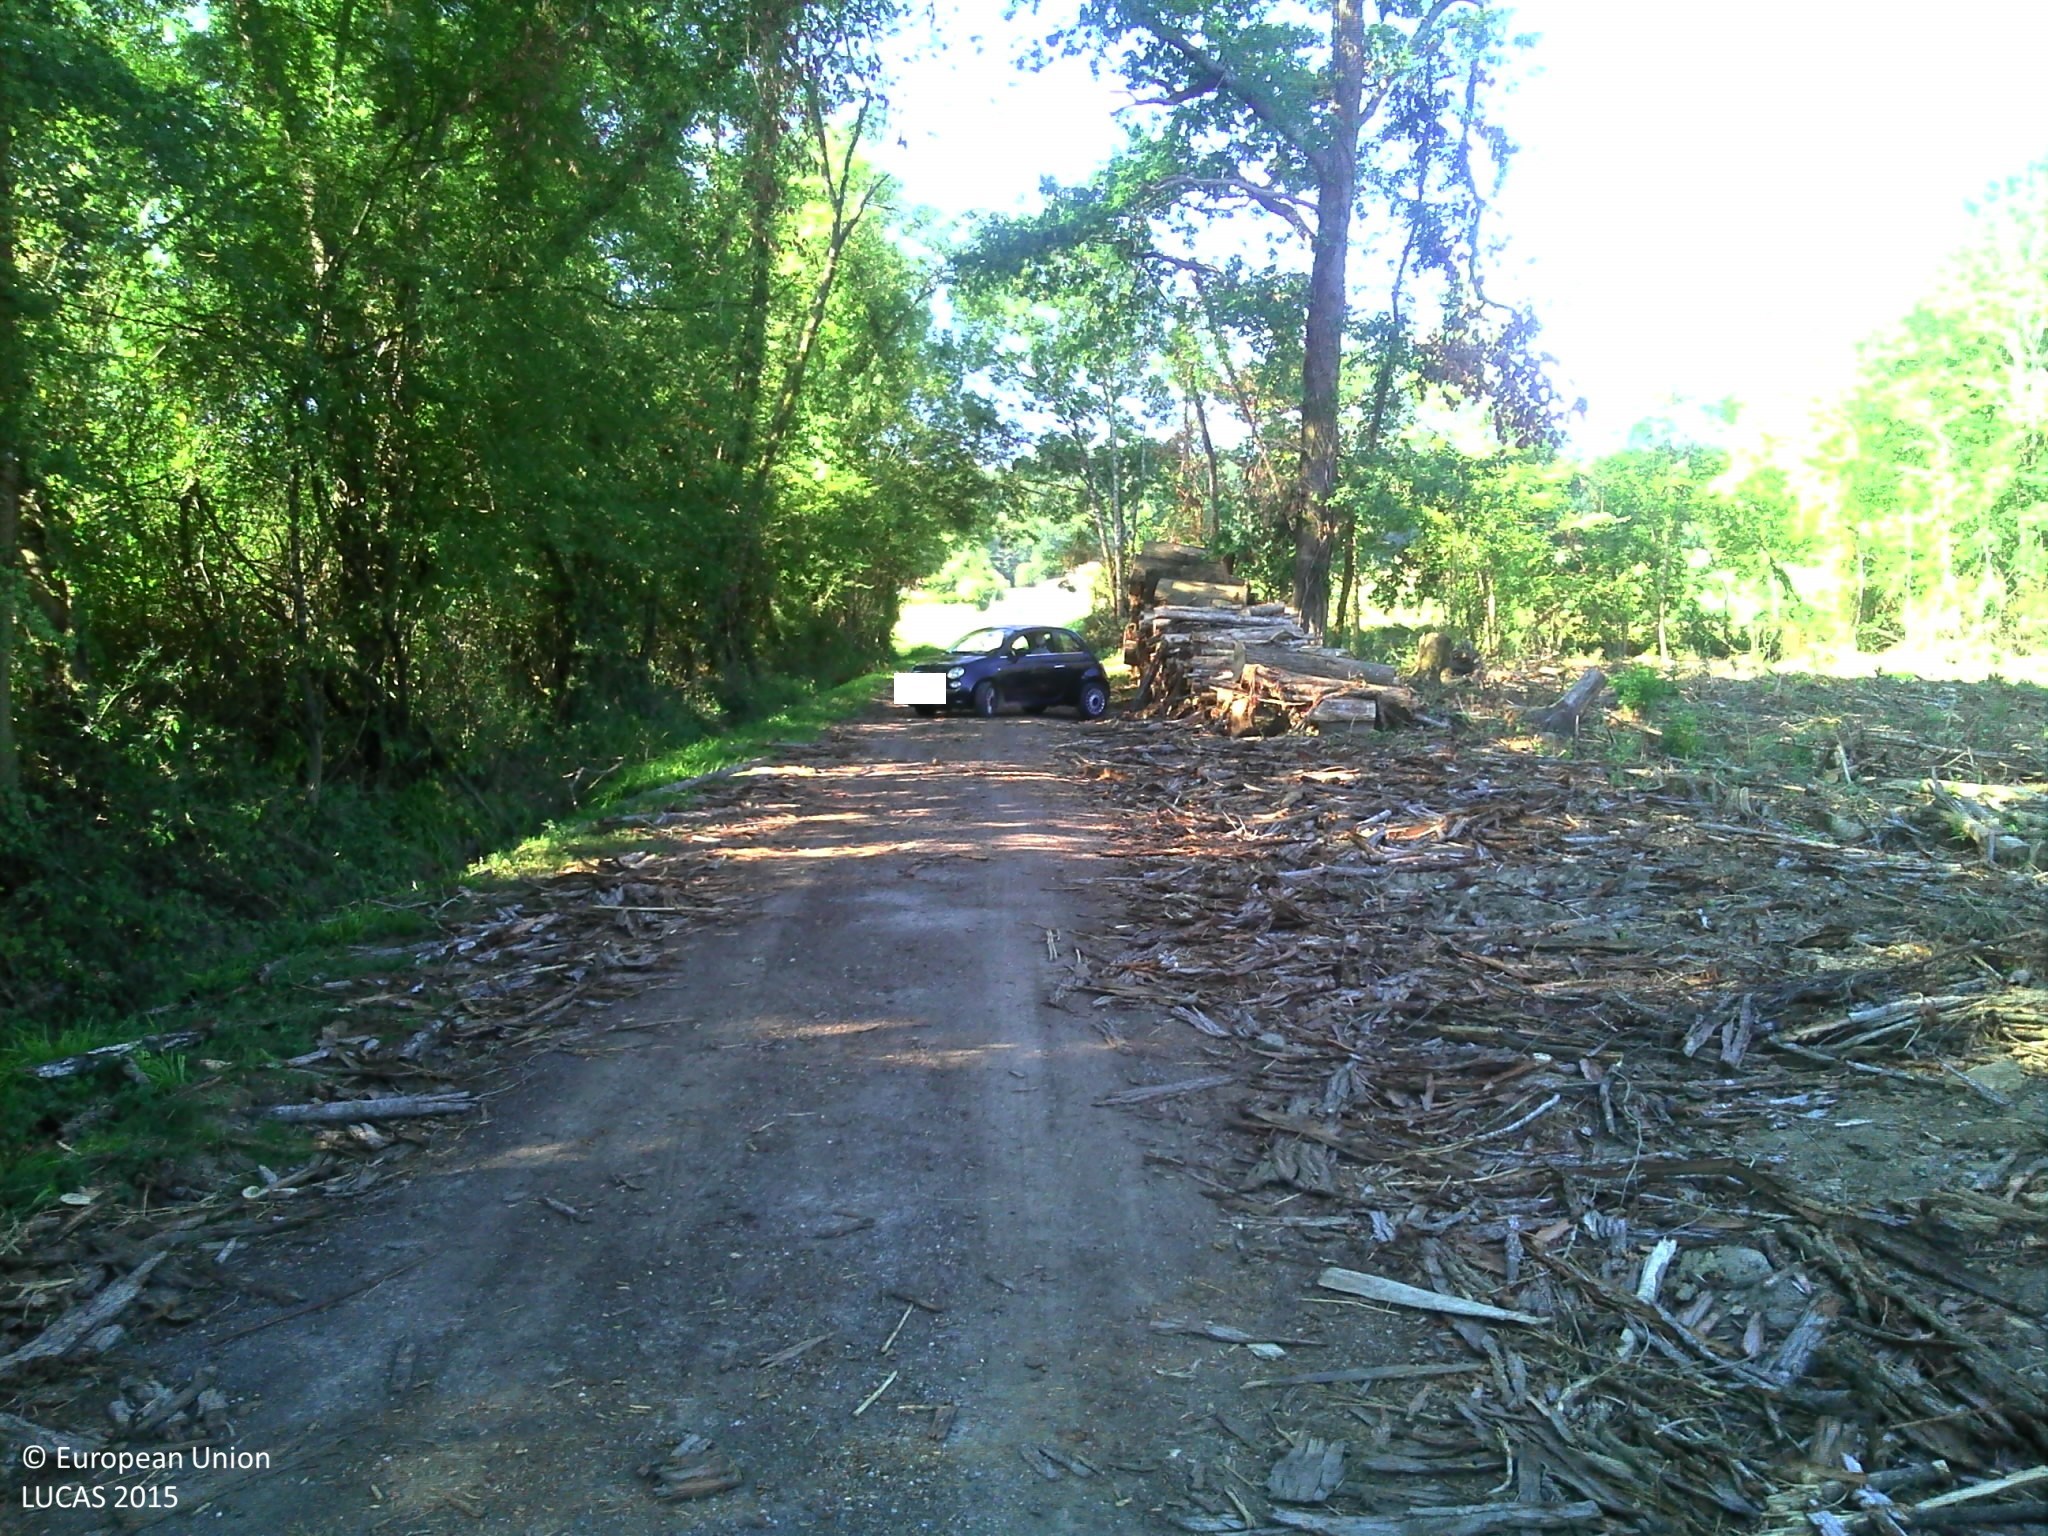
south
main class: Grassland
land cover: Grassland without tree/shrub cover
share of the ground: > 75 %
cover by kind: herbaceous plants 100 %
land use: Agriculture (excluding fallow land and kitchen gardens)
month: July
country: FR
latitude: 43.6580
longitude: -1.1388
